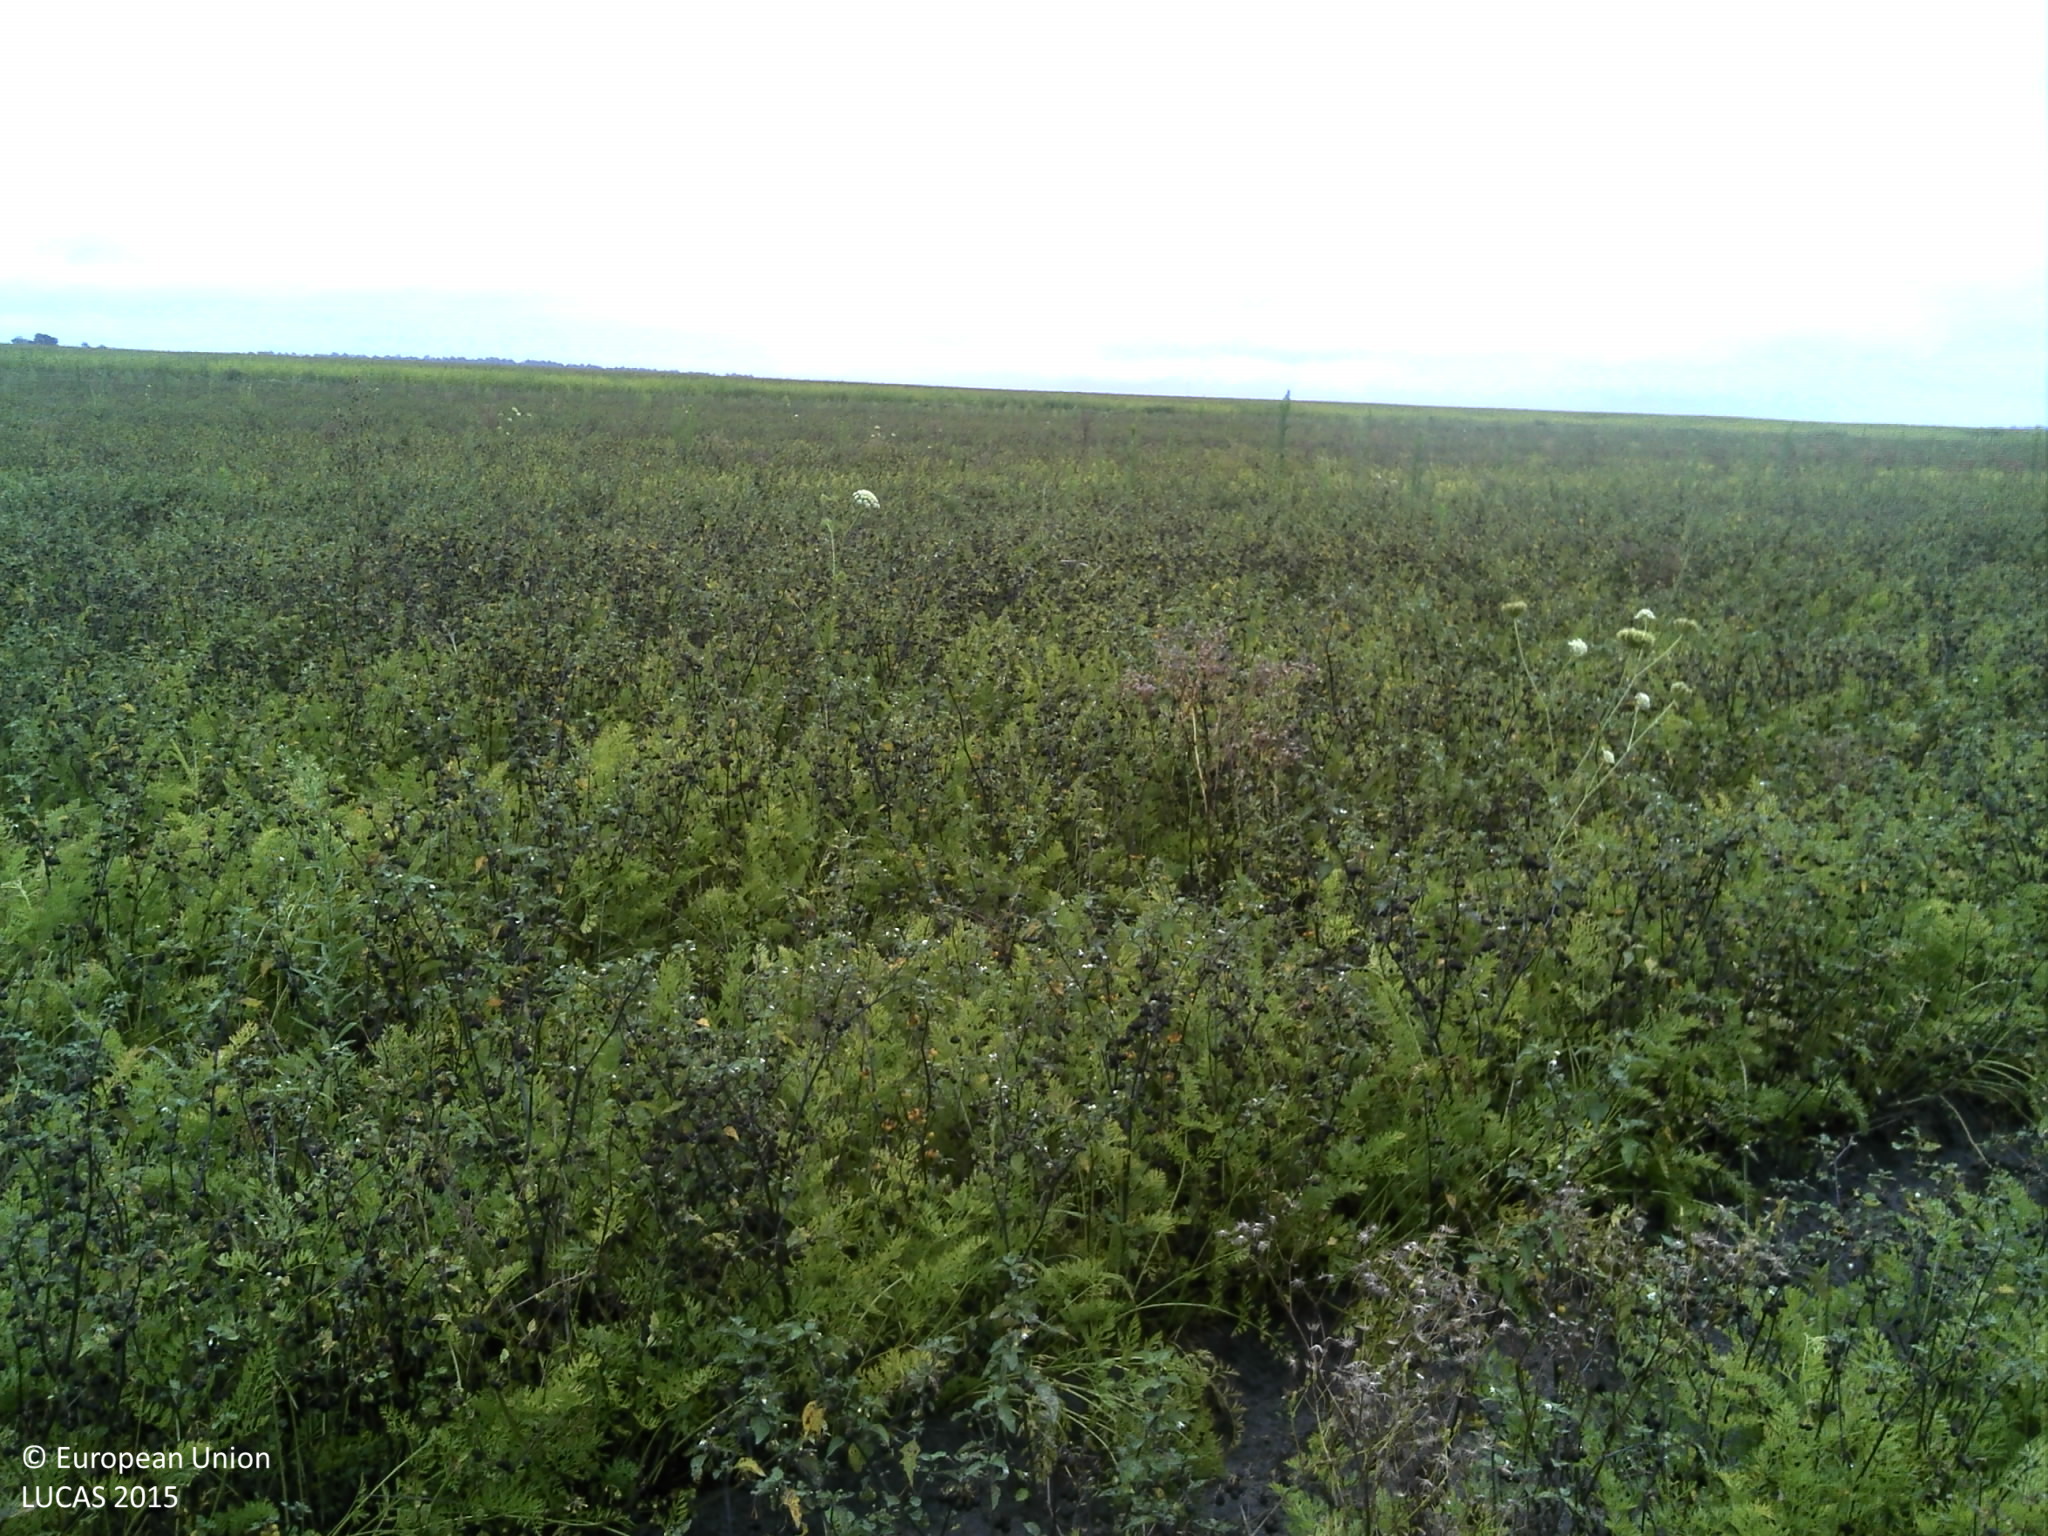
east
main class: Cropland
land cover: Other root crops
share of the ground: > 75 %
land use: Agriculture (excluding fallow land and kitchen gardens)
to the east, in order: Other root crops; Other bare soil; Grass margins; Ditches and canals; Shruby margins; Maize
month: August
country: FR
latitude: 44.4487
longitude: -0.8887
